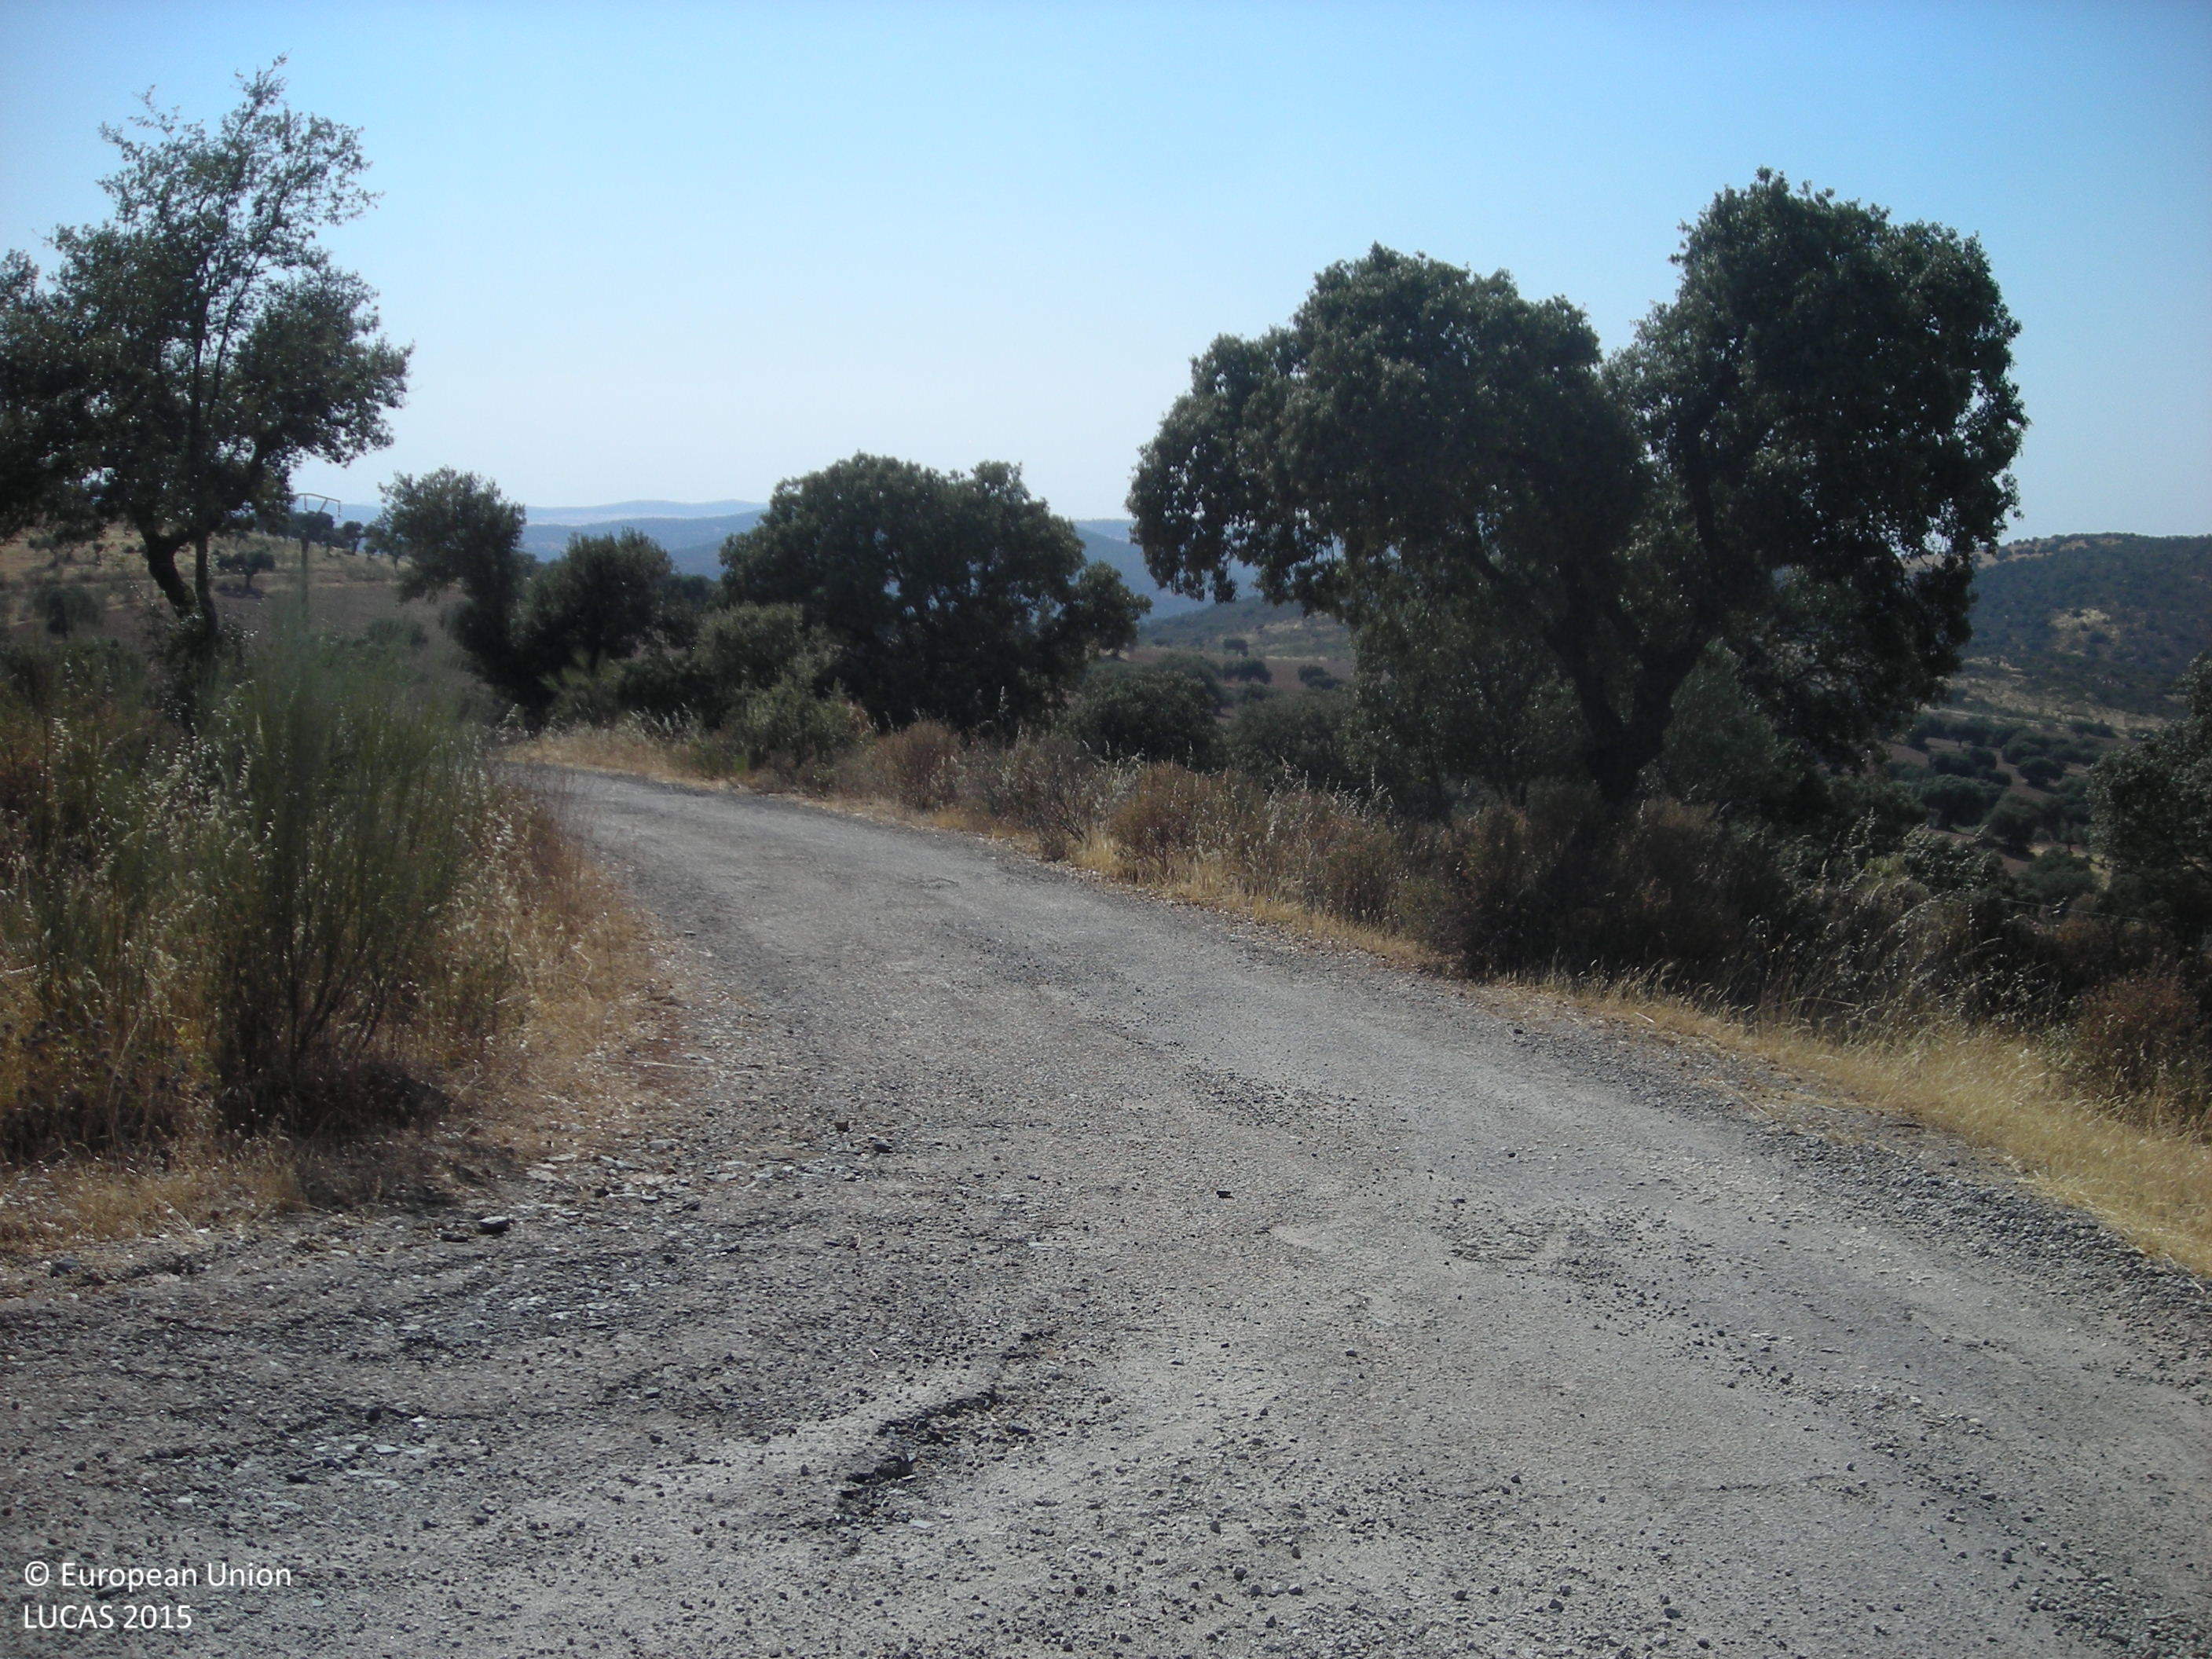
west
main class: Woodland
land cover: Broadleaved woodland
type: broadleaved evergreen forest
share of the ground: > 75 %
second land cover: Grassland without tree/shrub cover
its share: 50 - 75 %
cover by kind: herbaceous plants 60 %, broadleaved forest trees 40 %
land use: Forestry
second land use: Agriculture (excluding fallow land and kitchen gardens)
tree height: > 5 m
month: June
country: ES
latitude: 38.5981
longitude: -5.7603
